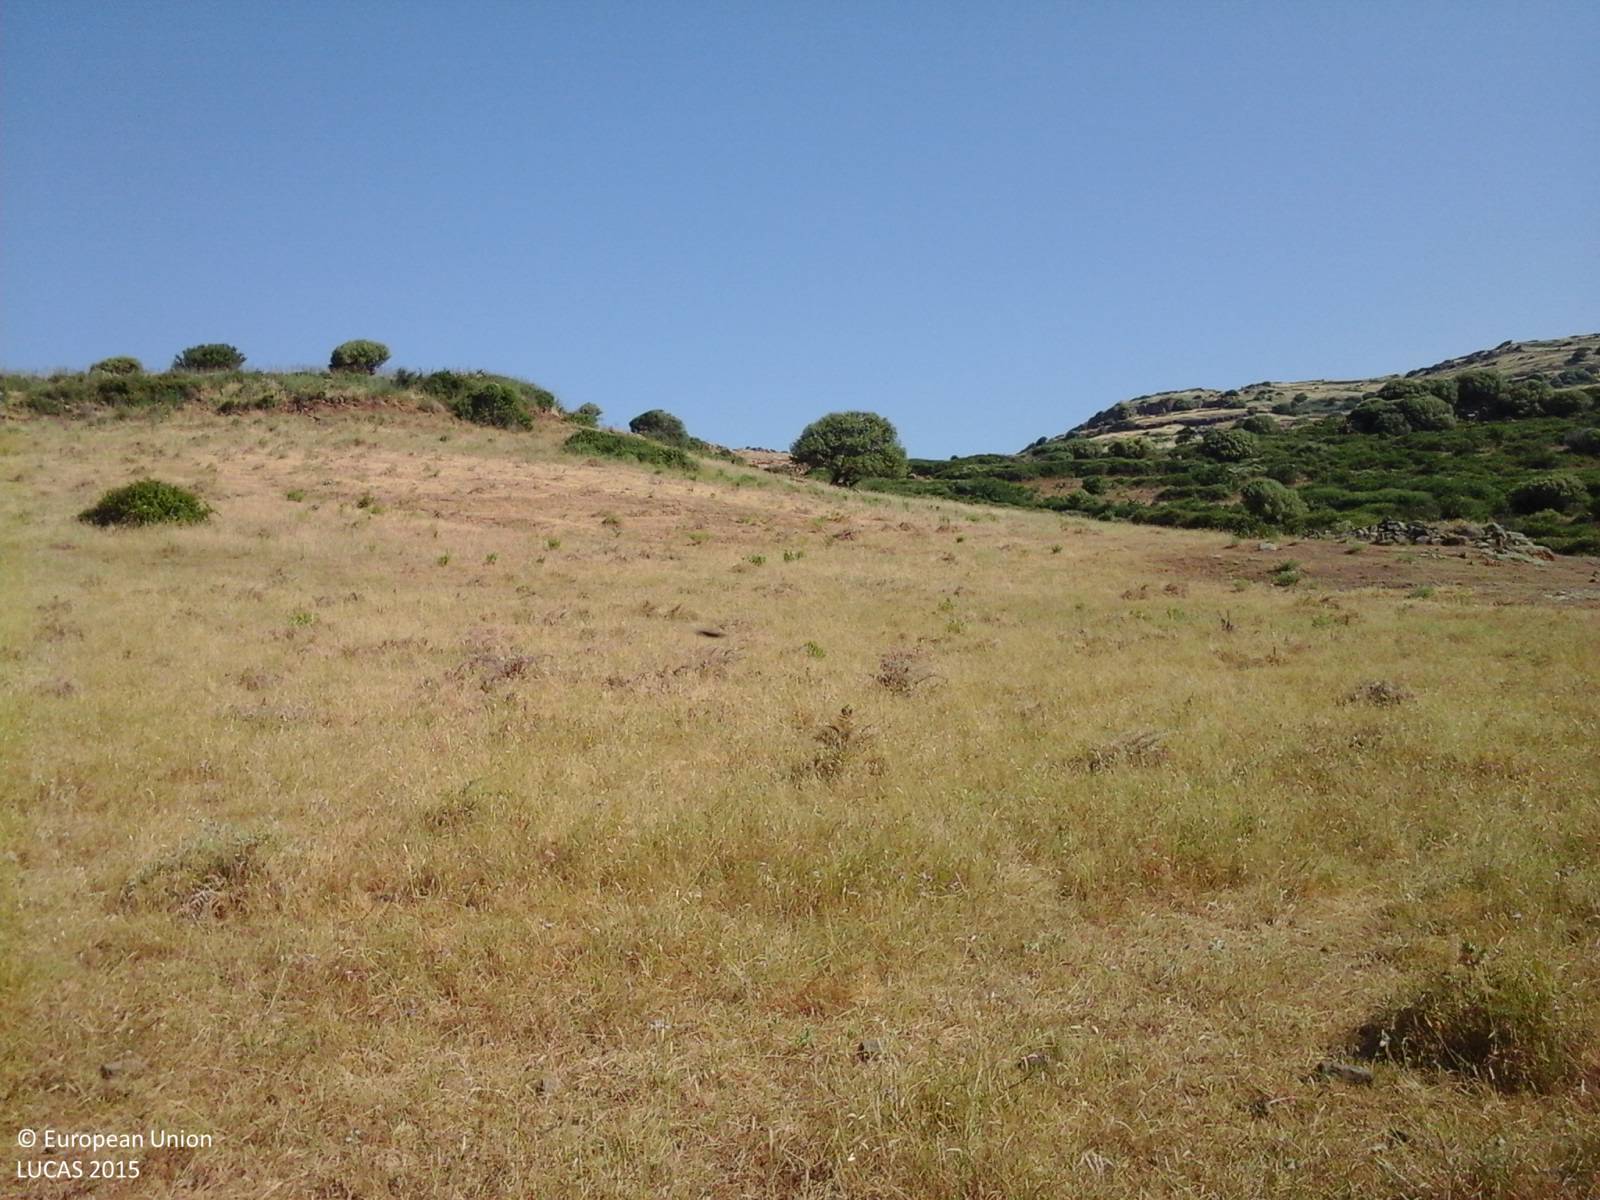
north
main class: Grassland
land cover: Grassland without tree/shrub cover
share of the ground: > 75 %
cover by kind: herbaceous plants 100 %
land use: Agriculture (excluding fallow land and kitchen gardens)
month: June
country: IT
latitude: 40.6930
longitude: 8.6928
